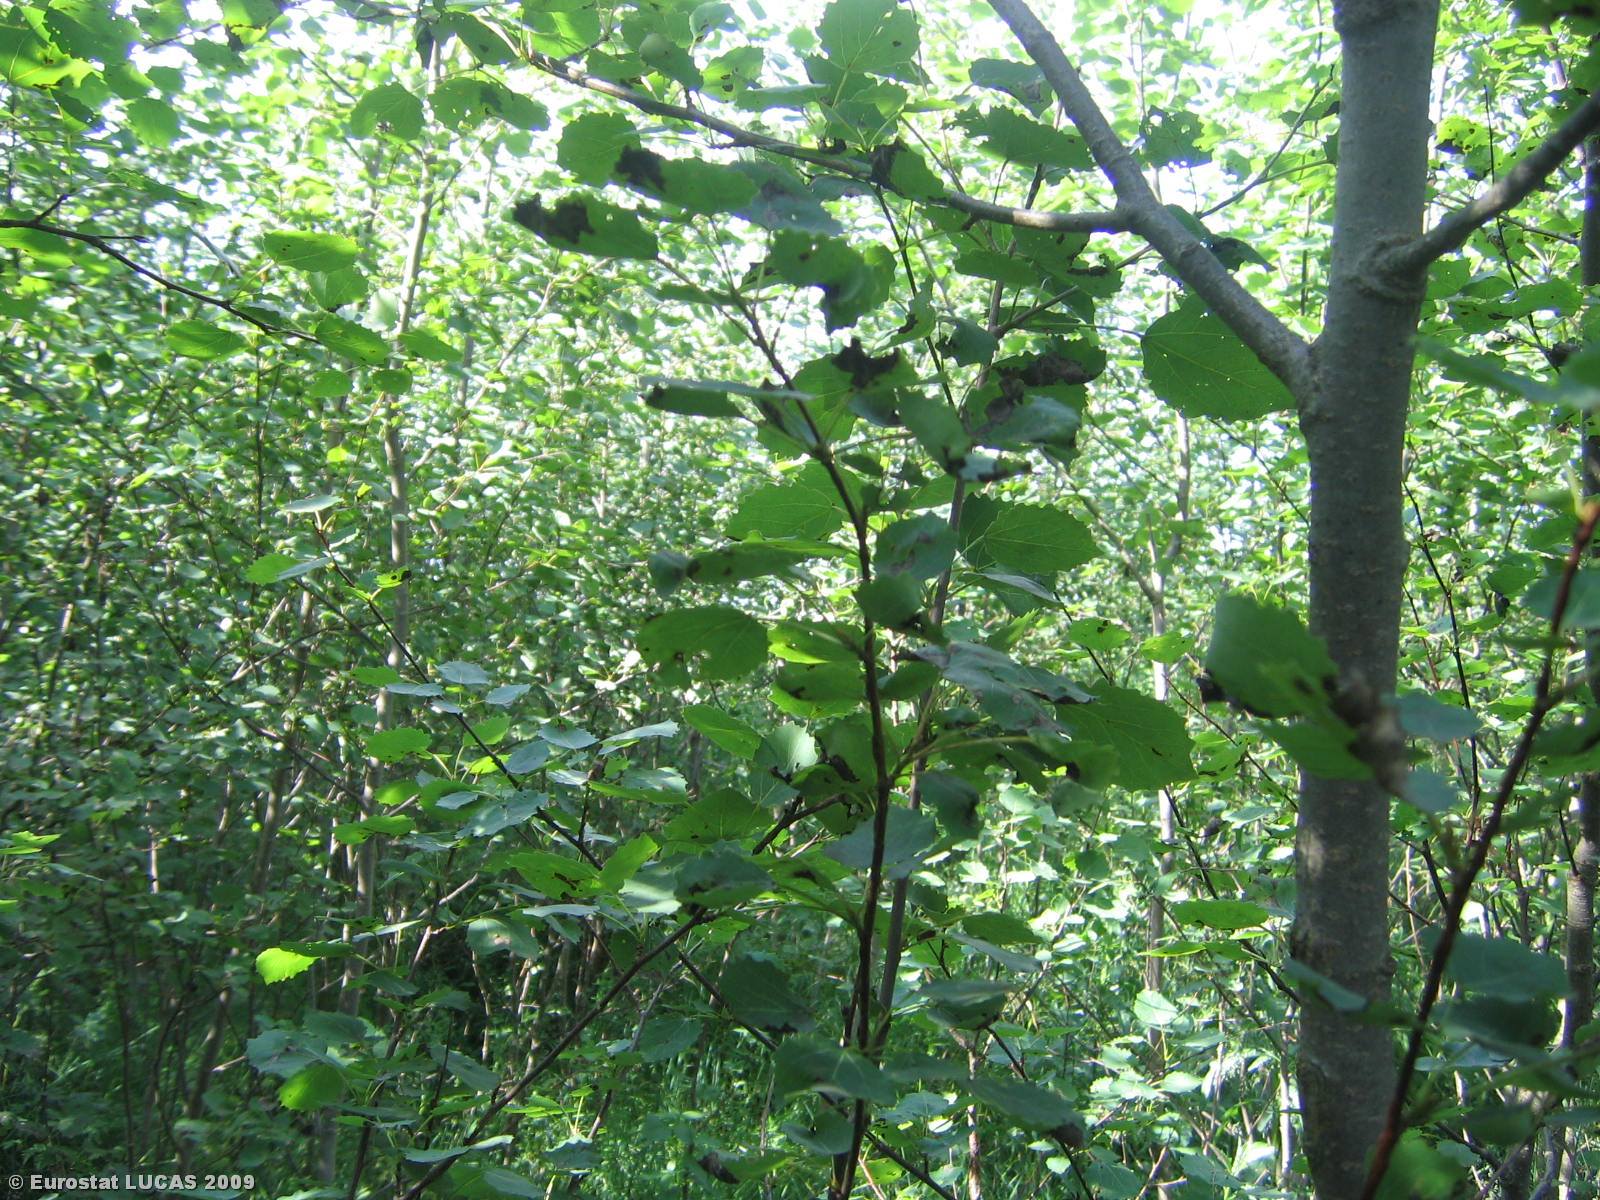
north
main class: Woodland
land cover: Broadleaved woodland
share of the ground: > 75 %
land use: Agriculture (excluding fallow land and kitchen gardens)
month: July
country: LT
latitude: 55.4912
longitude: 22.7749
